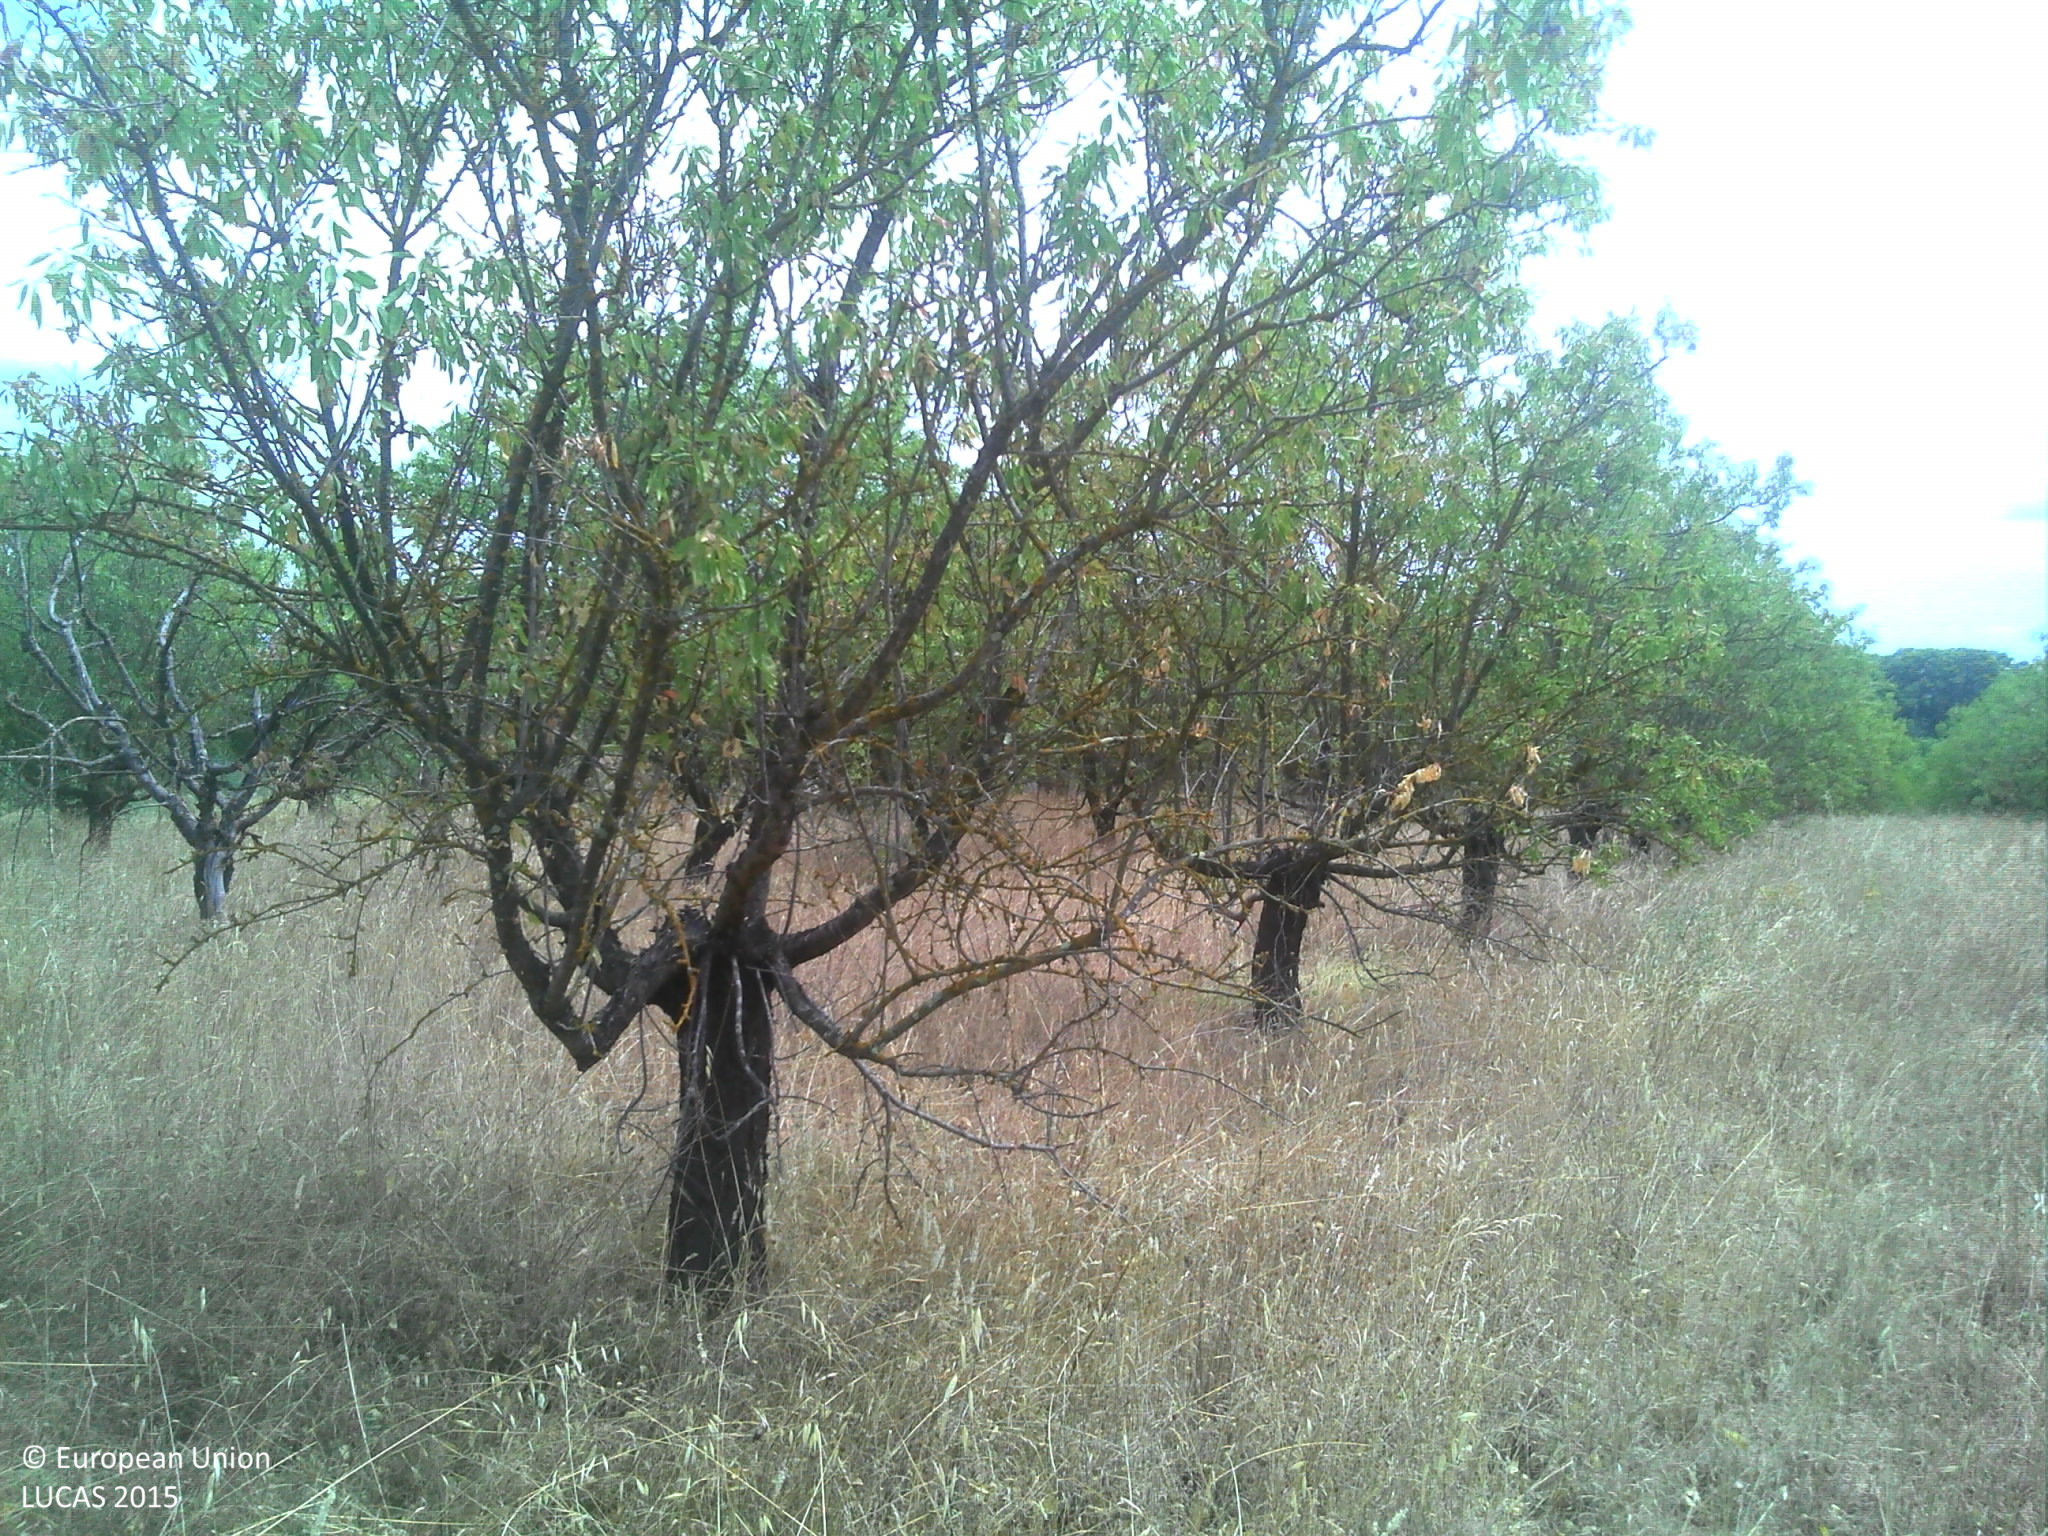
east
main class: Cropland
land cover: Other fruit trees and berries
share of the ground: 50 - 75 %
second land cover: Grassland without tree/shrub cover
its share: 50 - 75 %
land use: Agriculture (excluding fallow land and kitchen gardens)
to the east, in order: Other fruit trees and berries; Grassland without tree/shrub cover; Broadleaved woodland; Ditches and canals; Tracks; Vineyards
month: July
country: FR
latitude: 43.3825
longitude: 3.1585
